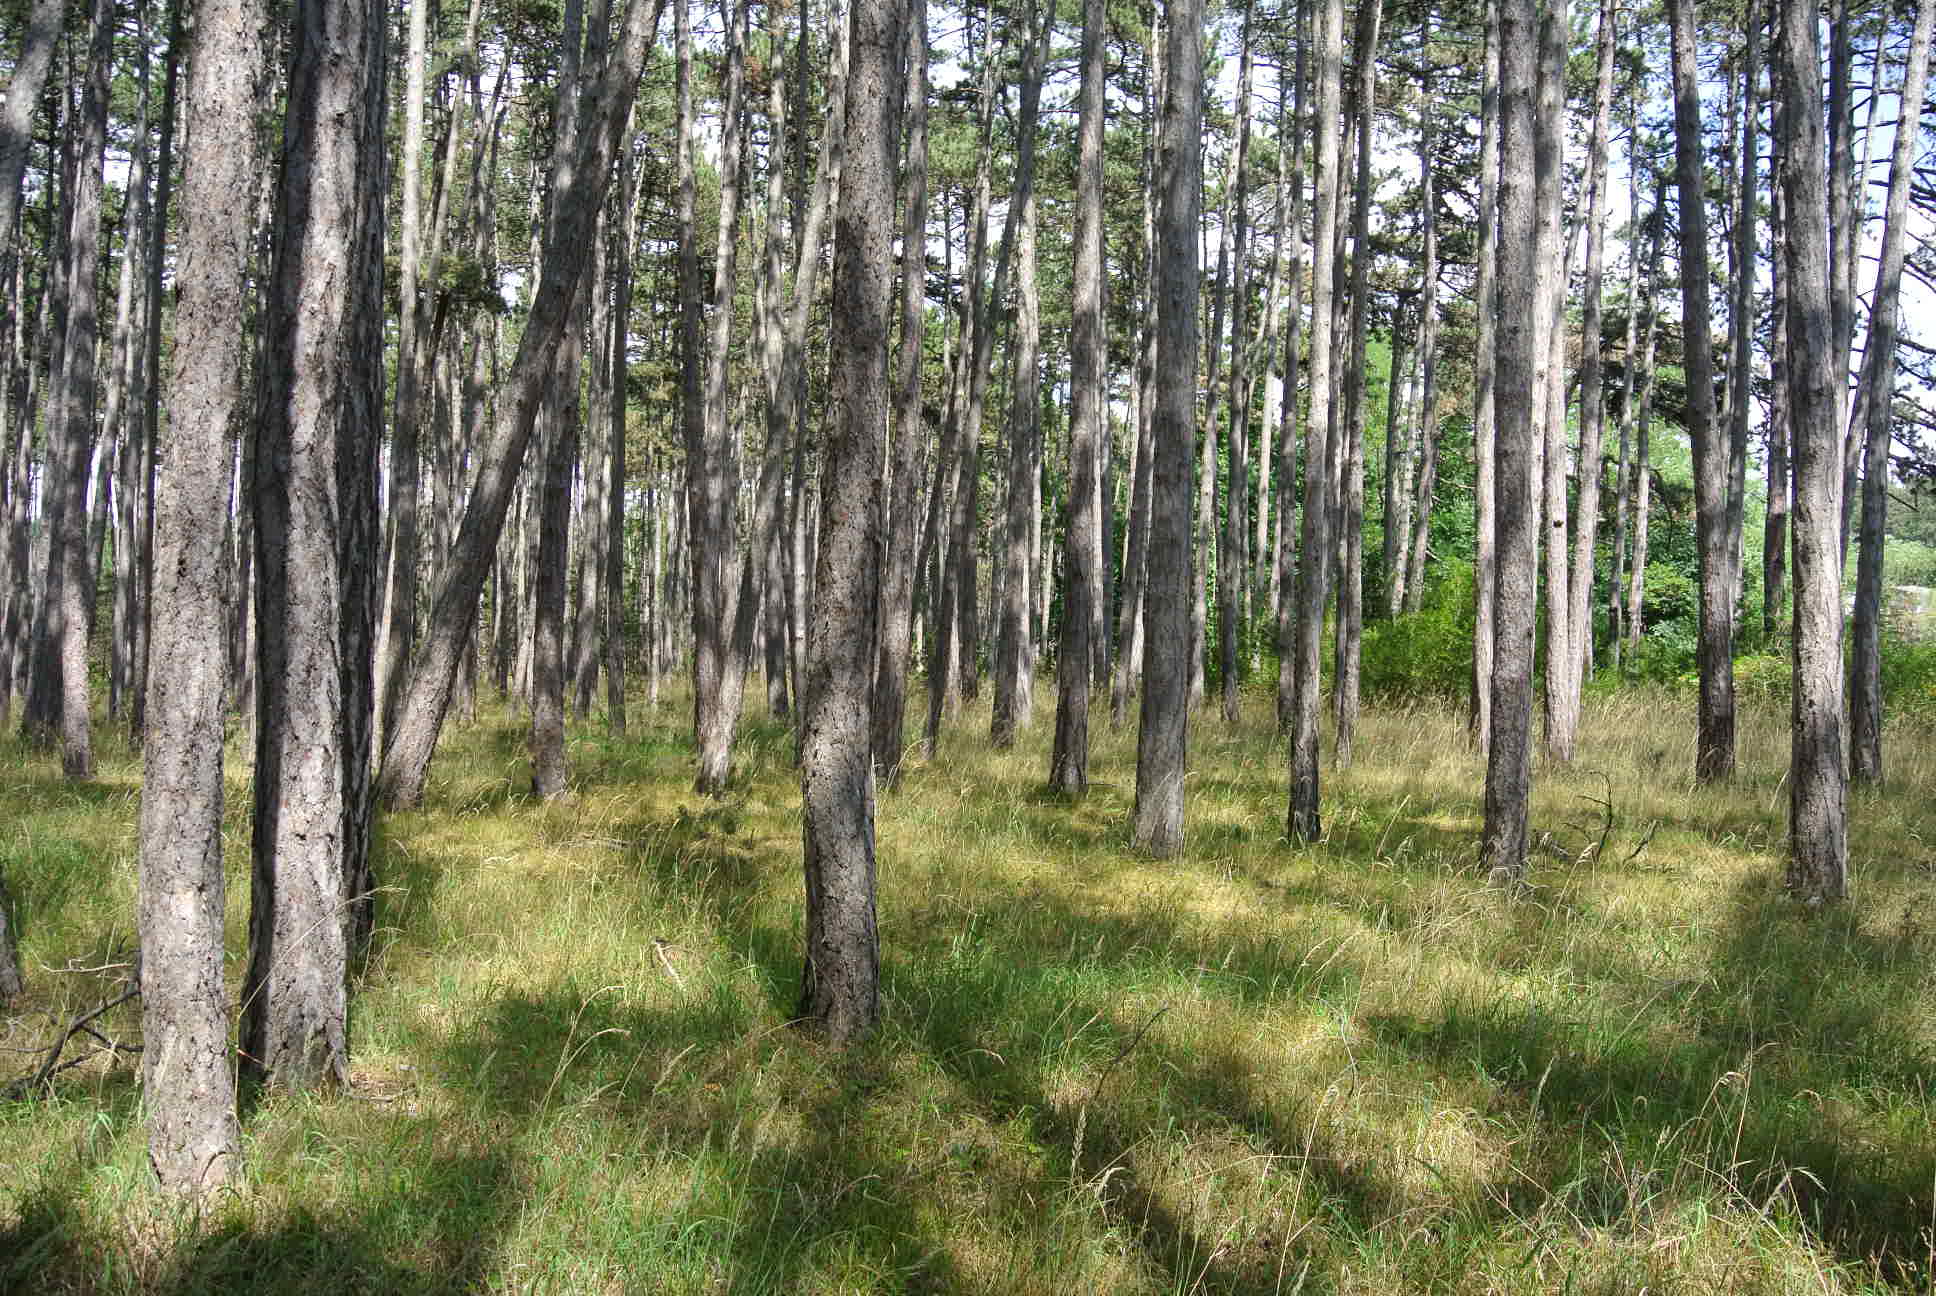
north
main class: Woodland
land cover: Pine dominated coniferous woodland
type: alpine coniferous forest
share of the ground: > 75 %
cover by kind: coniferous forest trees 100 %
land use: Forestry
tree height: > 5 m
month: July
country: AT
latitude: 47.7464
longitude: 16.1251
